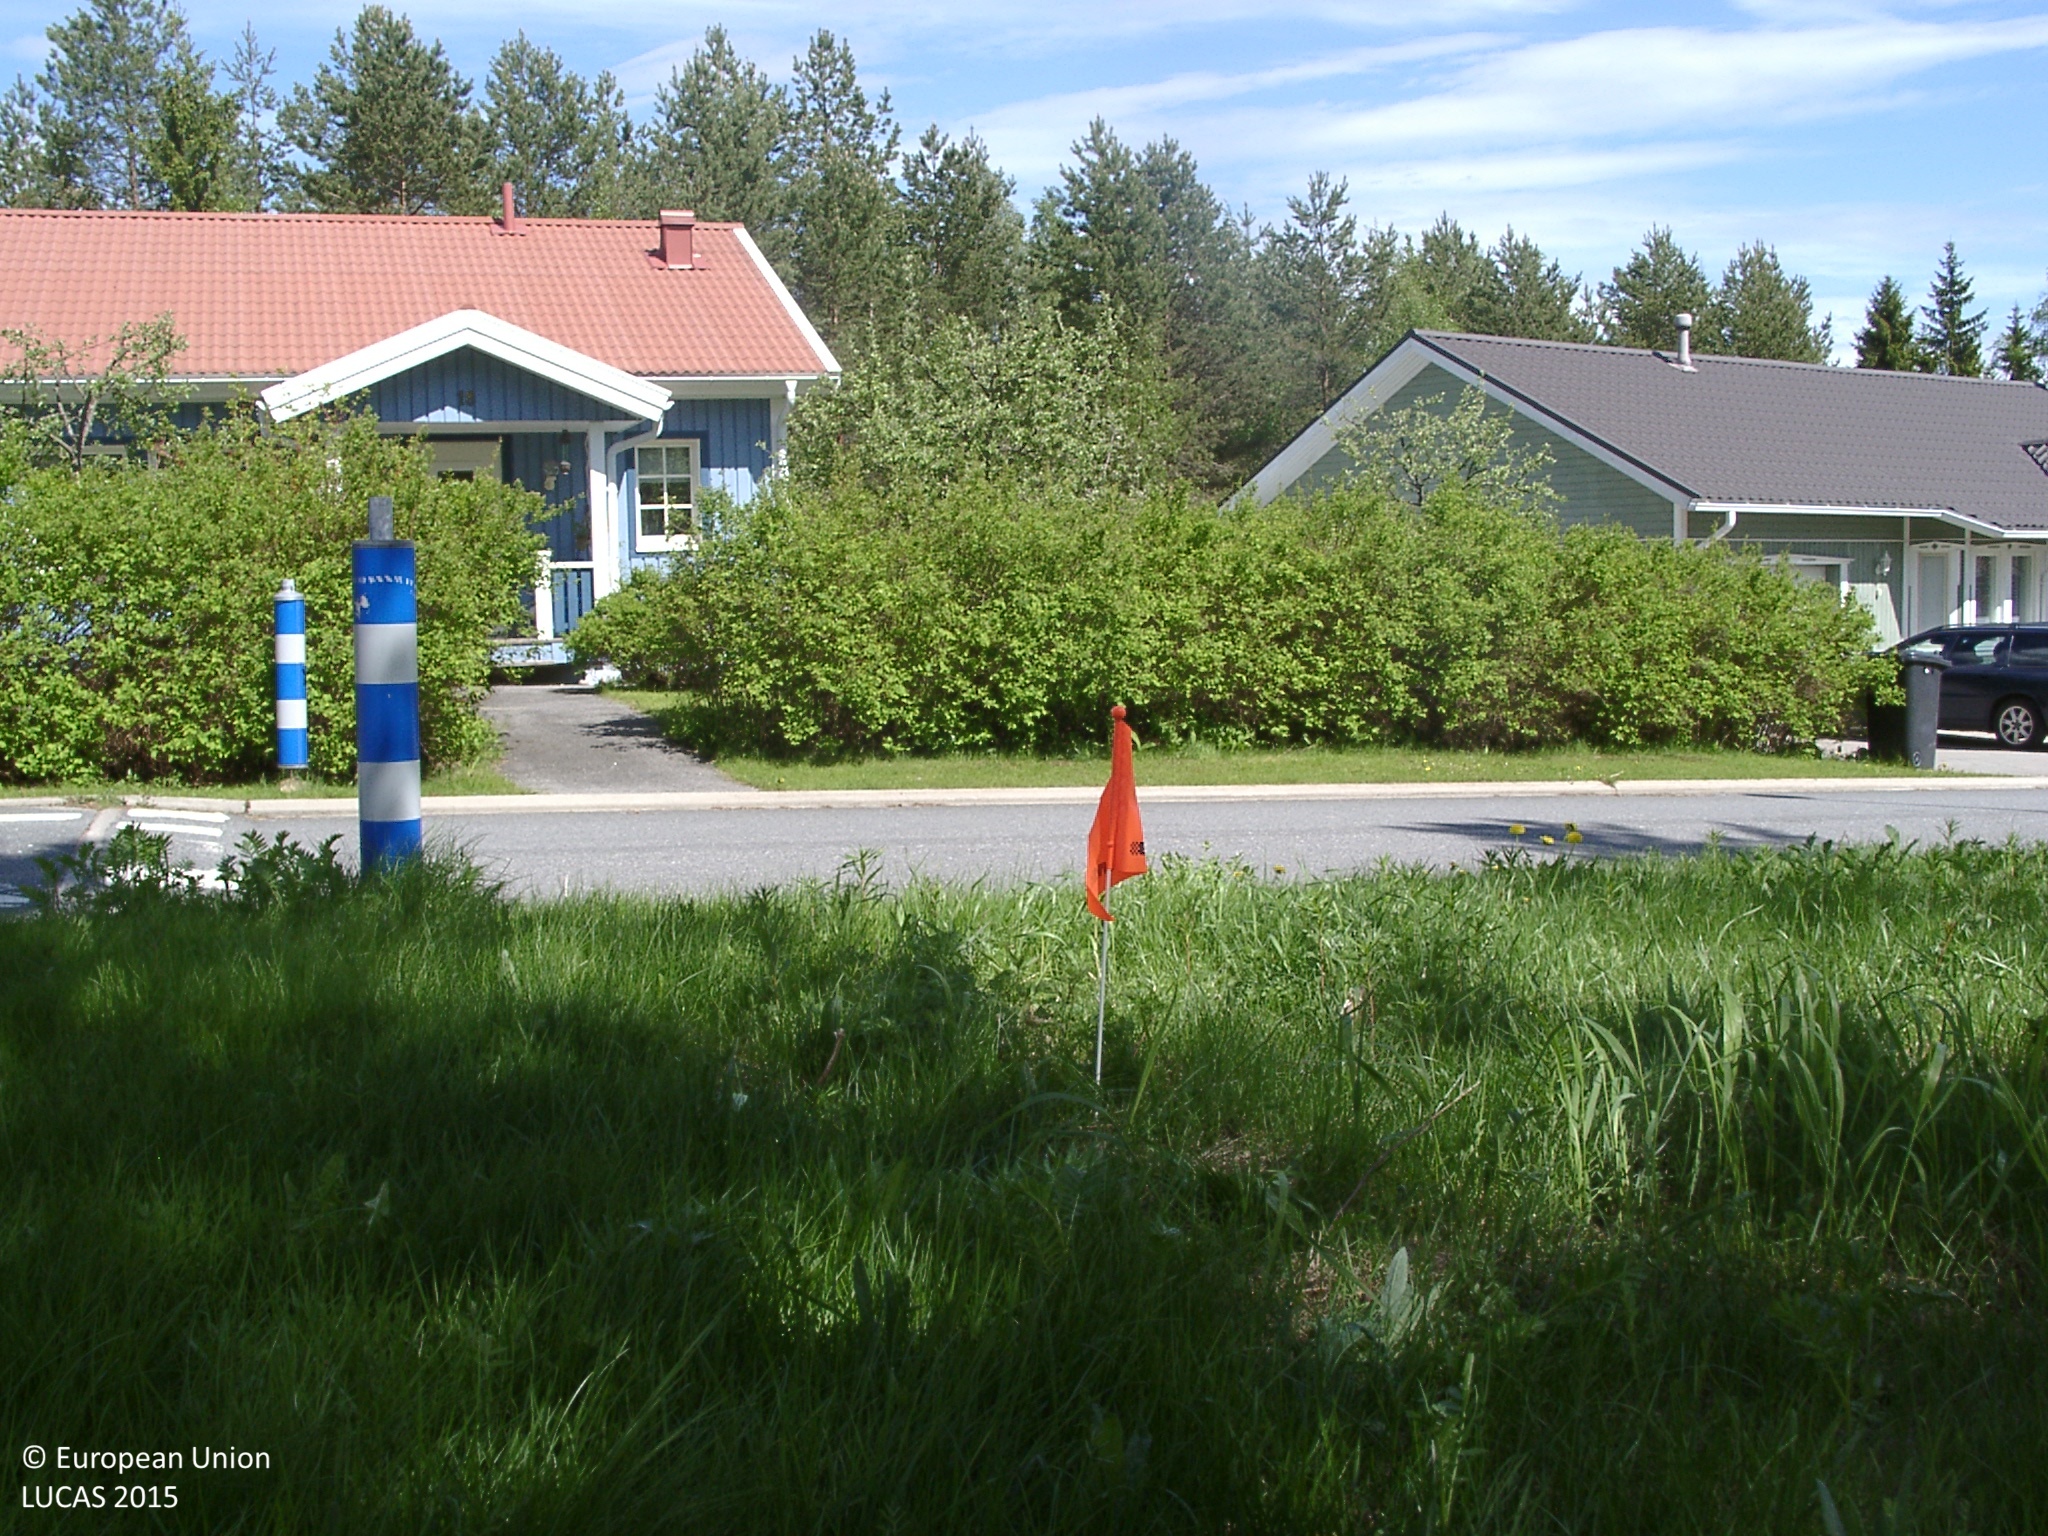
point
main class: Grassland
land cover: Grassland with sparse tree/shrub cover
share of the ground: > 75 %
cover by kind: herbaceous plants 90 %, broadleaved forest trees 5 %, shrubs 5 %
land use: Semi-natural and natural areas not in use
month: June
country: FI
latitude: 62.2298
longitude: 25.6436
